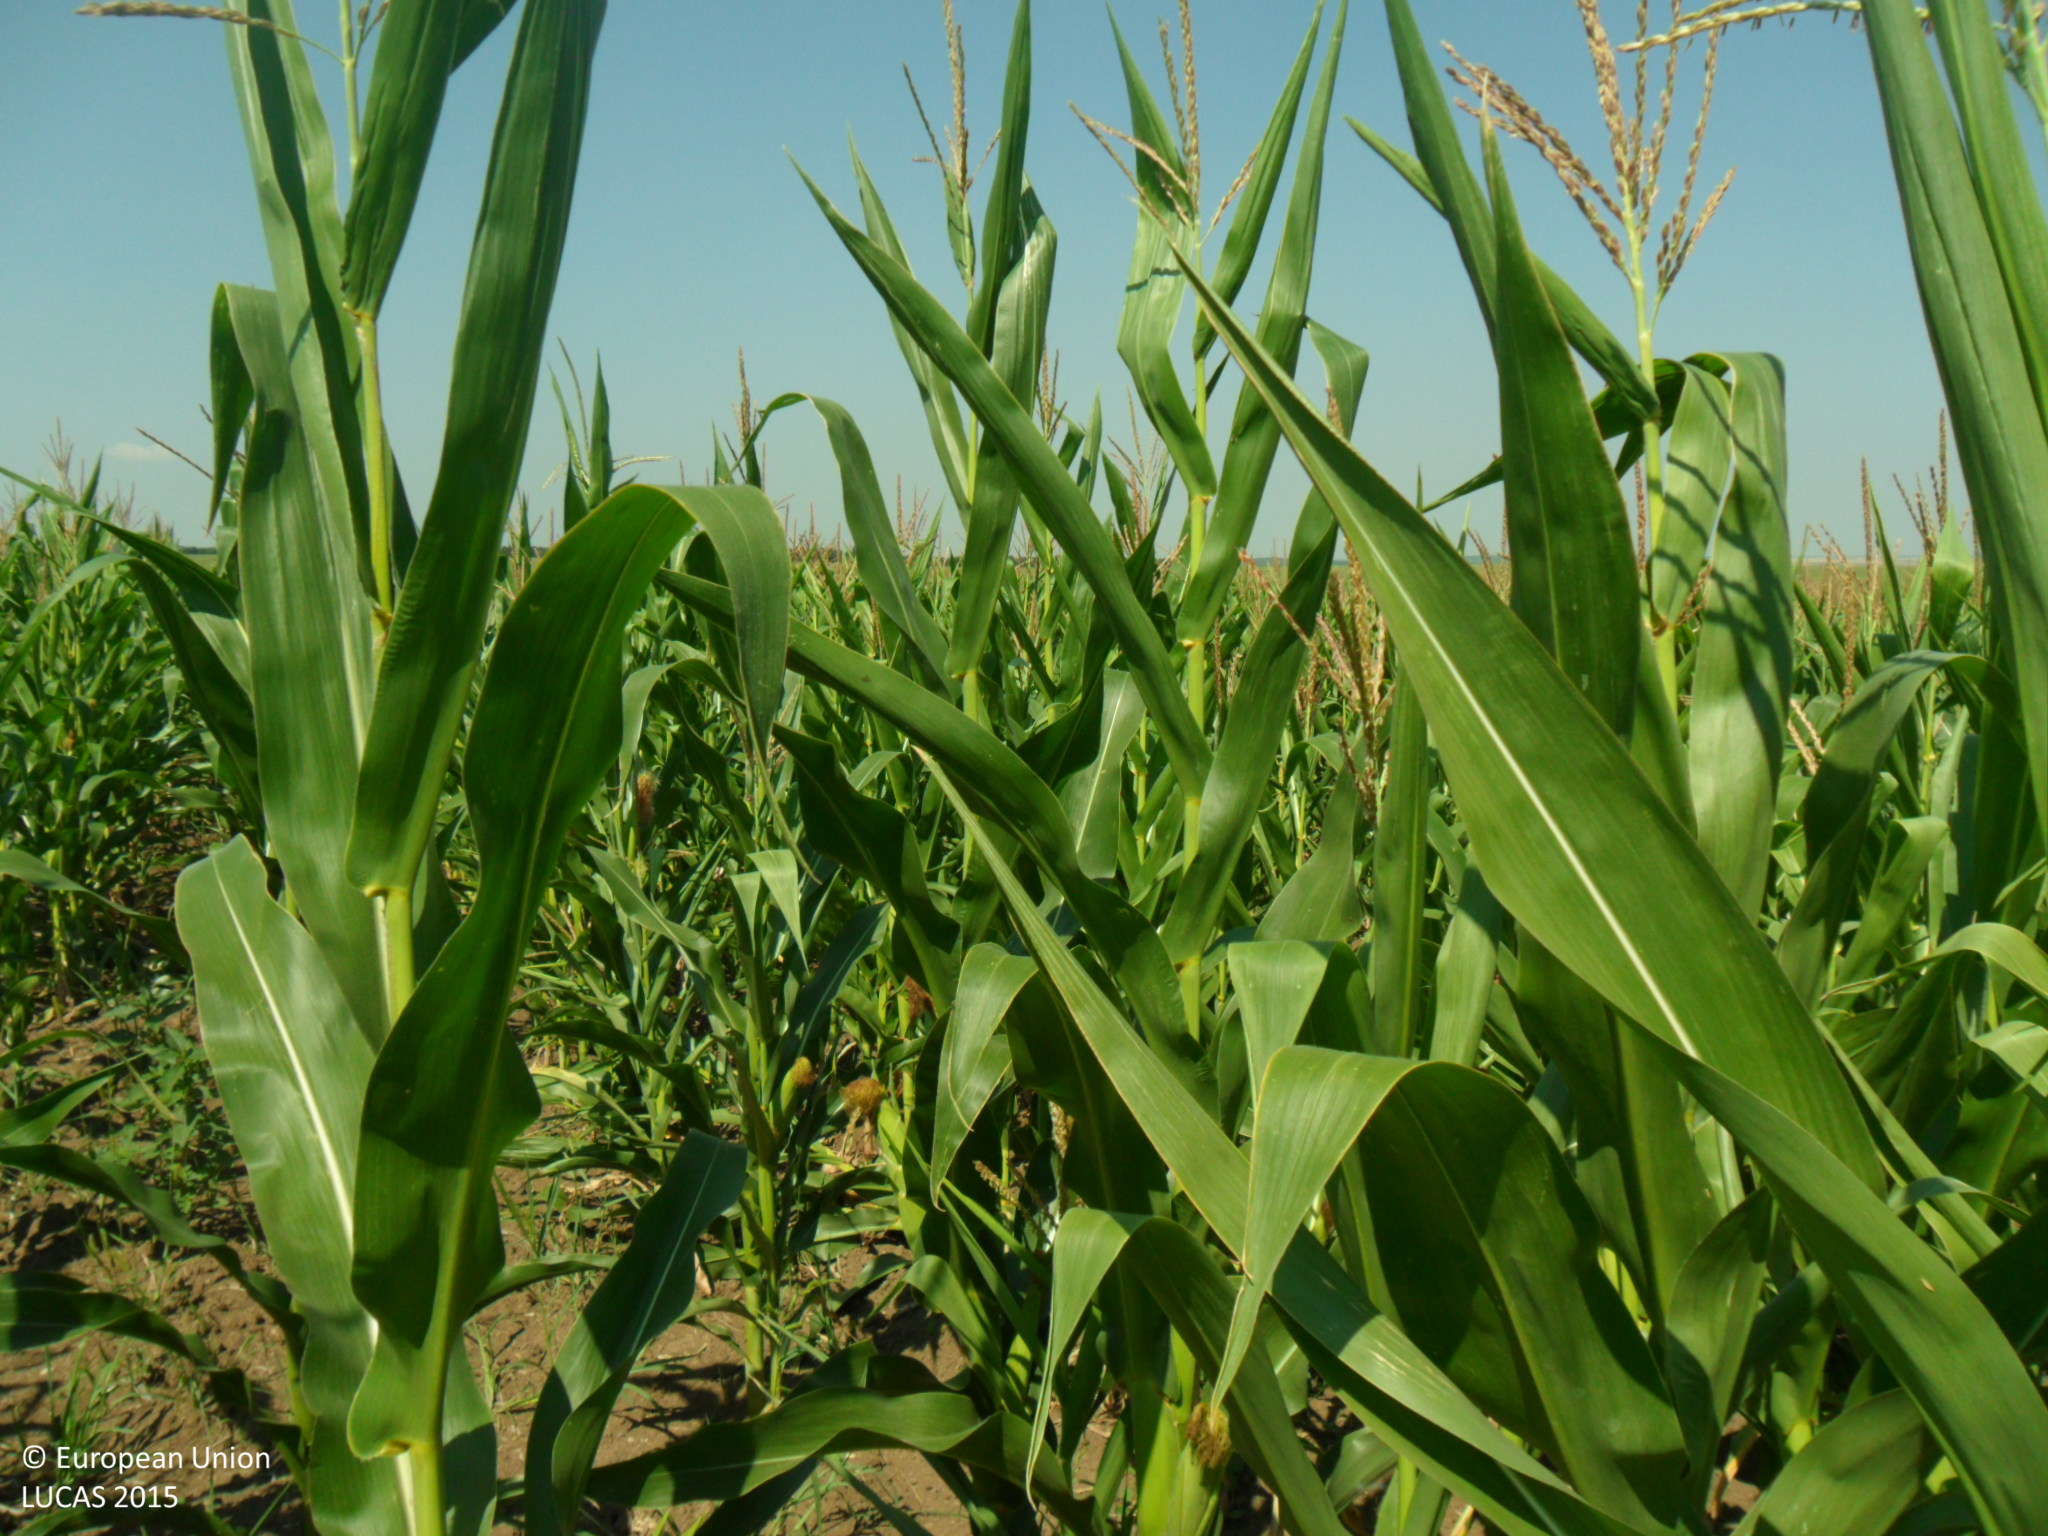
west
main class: Cropland
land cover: Maize
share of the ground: > 75 %
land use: Agriculture (excluding fallow land and kitchen gardens)
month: July
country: BG
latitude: 43.6005
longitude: 27.3092
